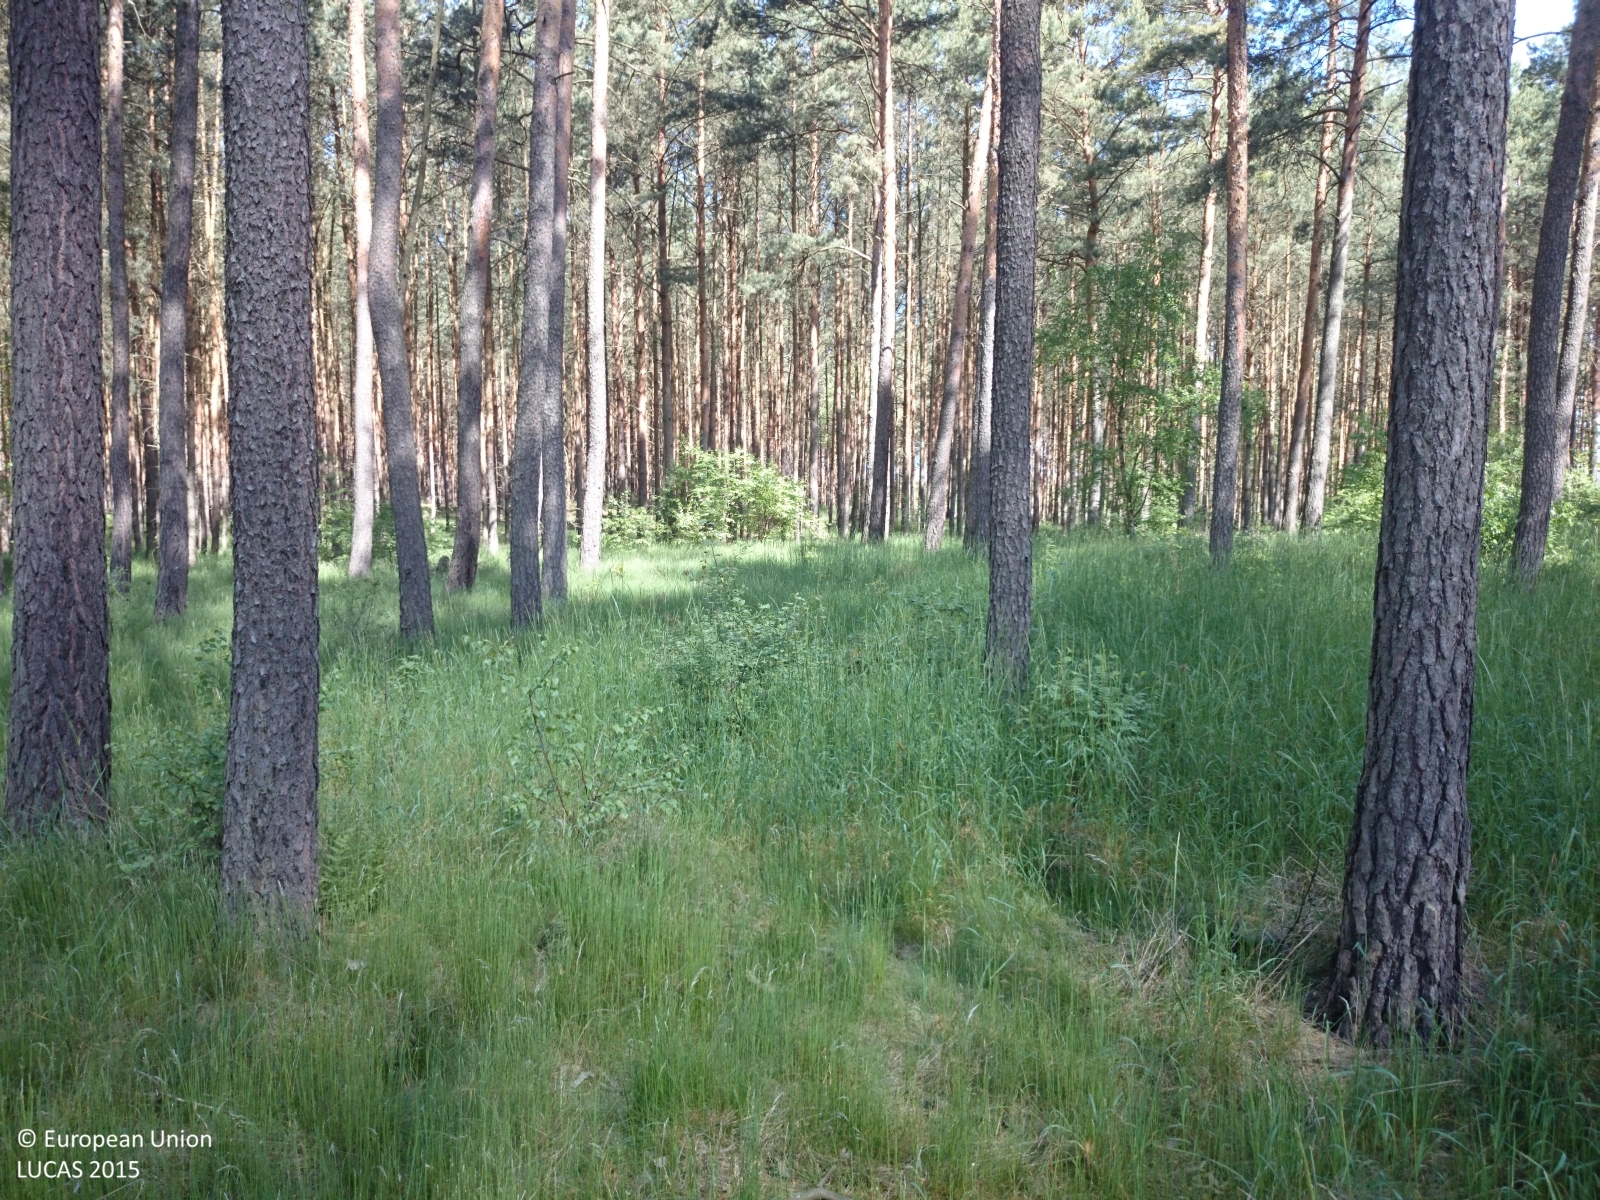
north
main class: Woodland
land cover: Pine dominated coniferous woodland
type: hemiboreal forest and nemoral coniferous forest and mixed broadleaved-coniferous forest
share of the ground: 50 - 75 %
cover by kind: coniferous forest trees 65 %, herbaceous plants 35 %
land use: Forestry
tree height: > 5 m
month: May
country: PL
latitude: 52.5313
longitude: 15.6503
